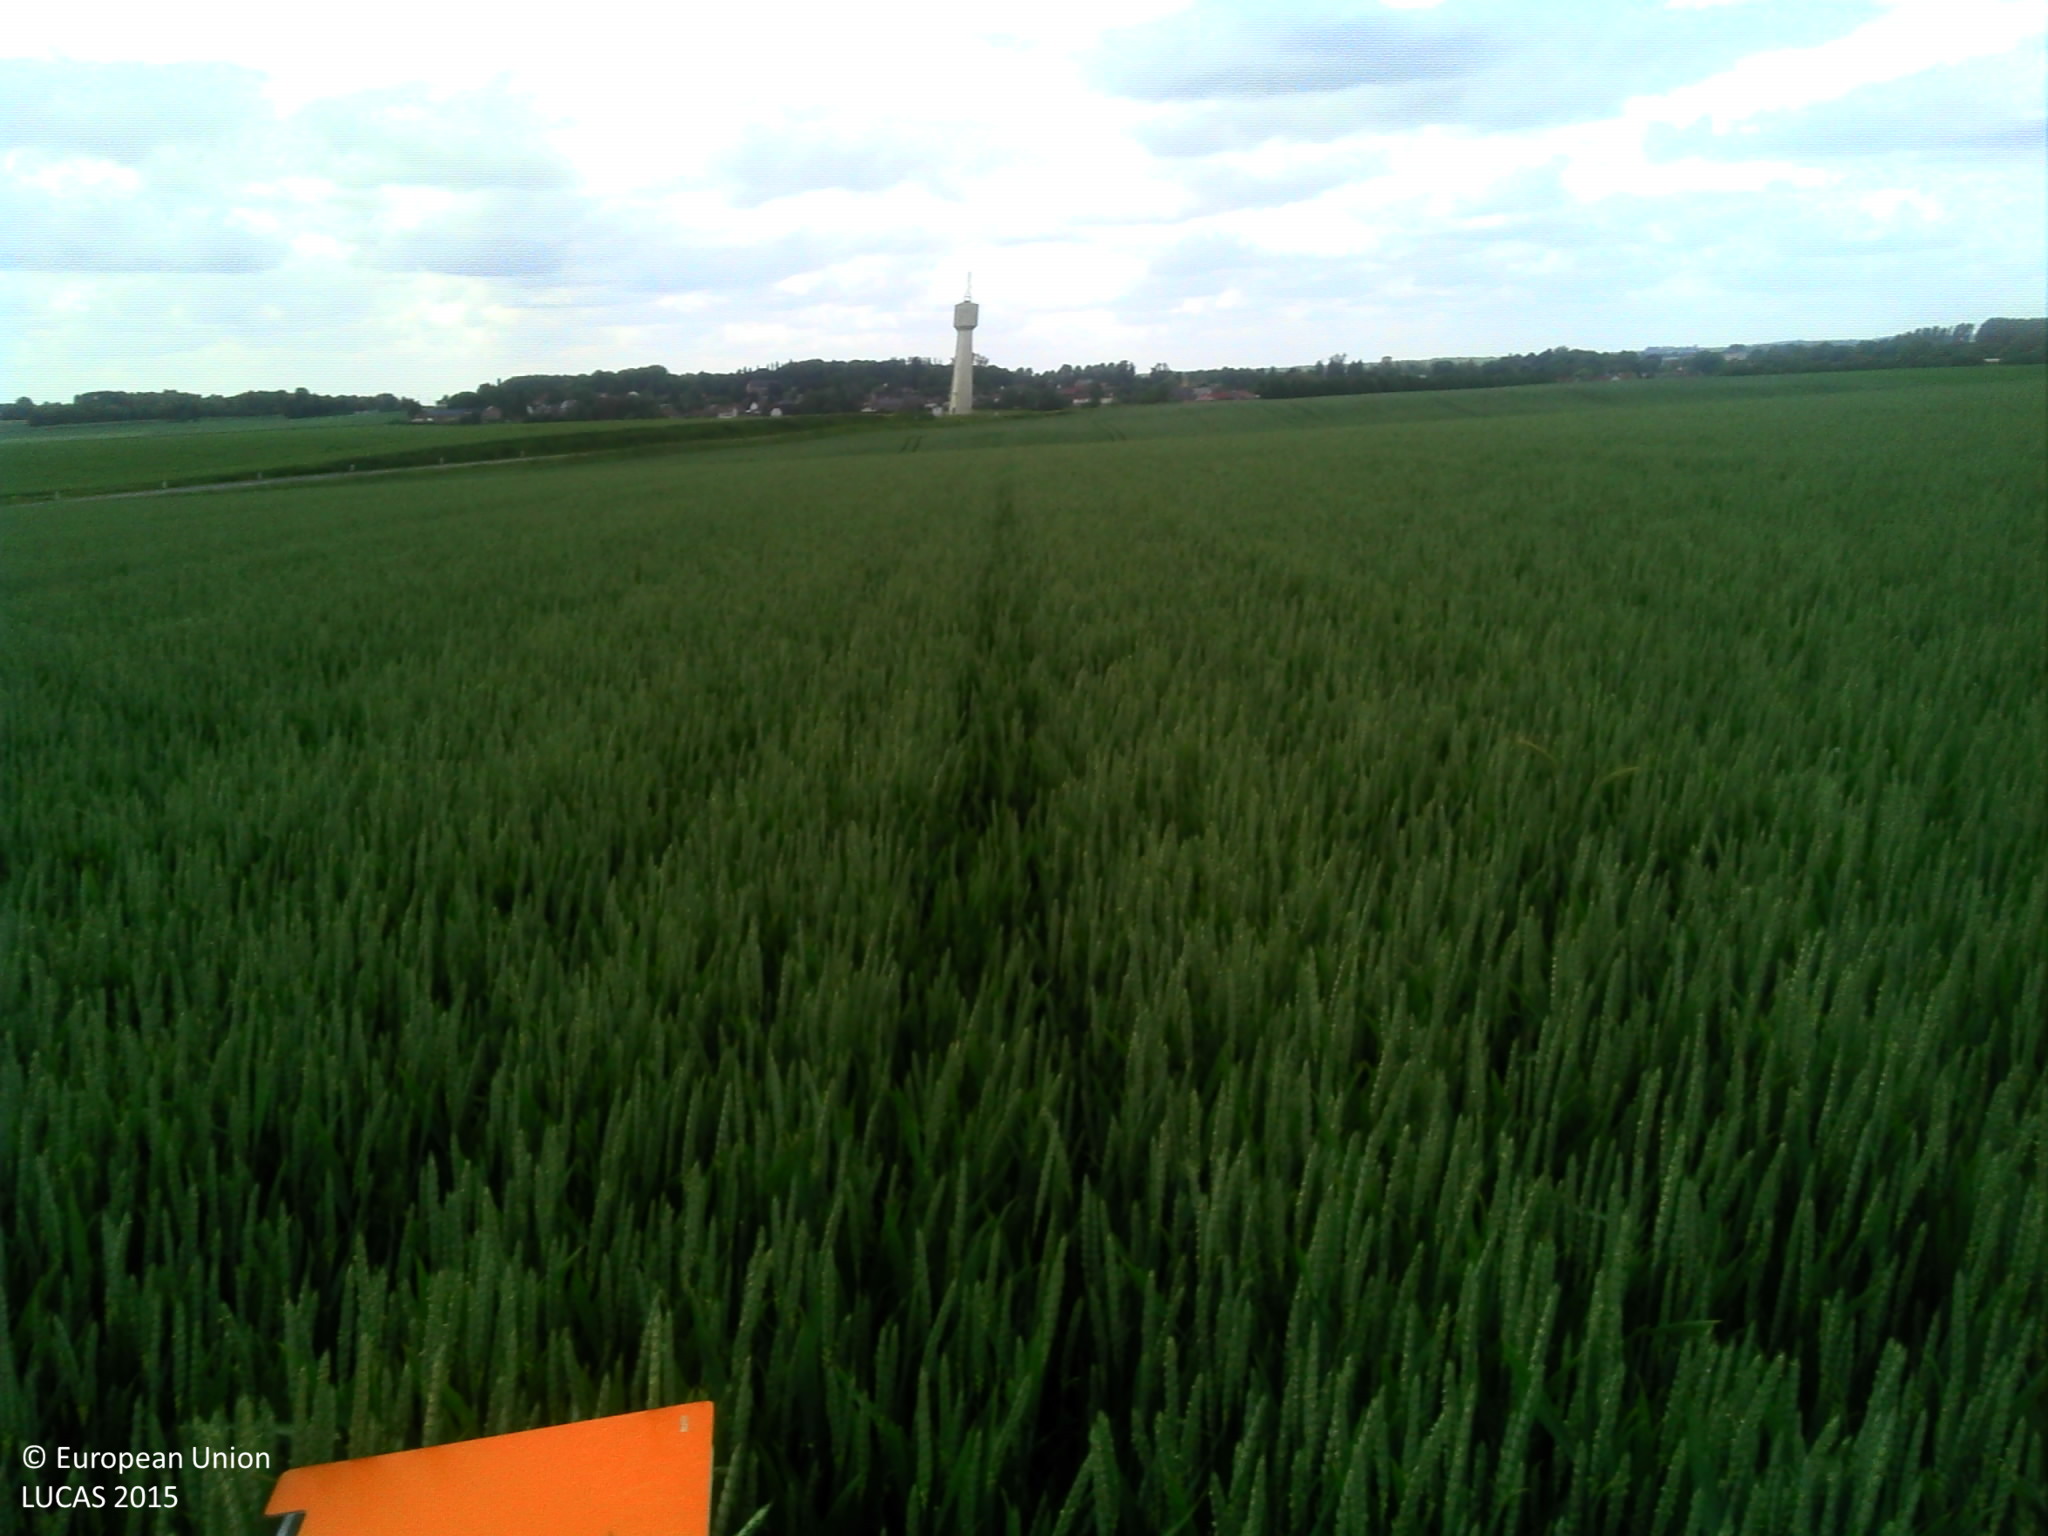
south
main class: Cropland
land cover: Common wheat
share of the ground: > 75 %
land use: Agriculture (excluding fallow land and kitchen gardens)
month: June
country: FR
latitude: 49.7502
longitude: 3.2602
